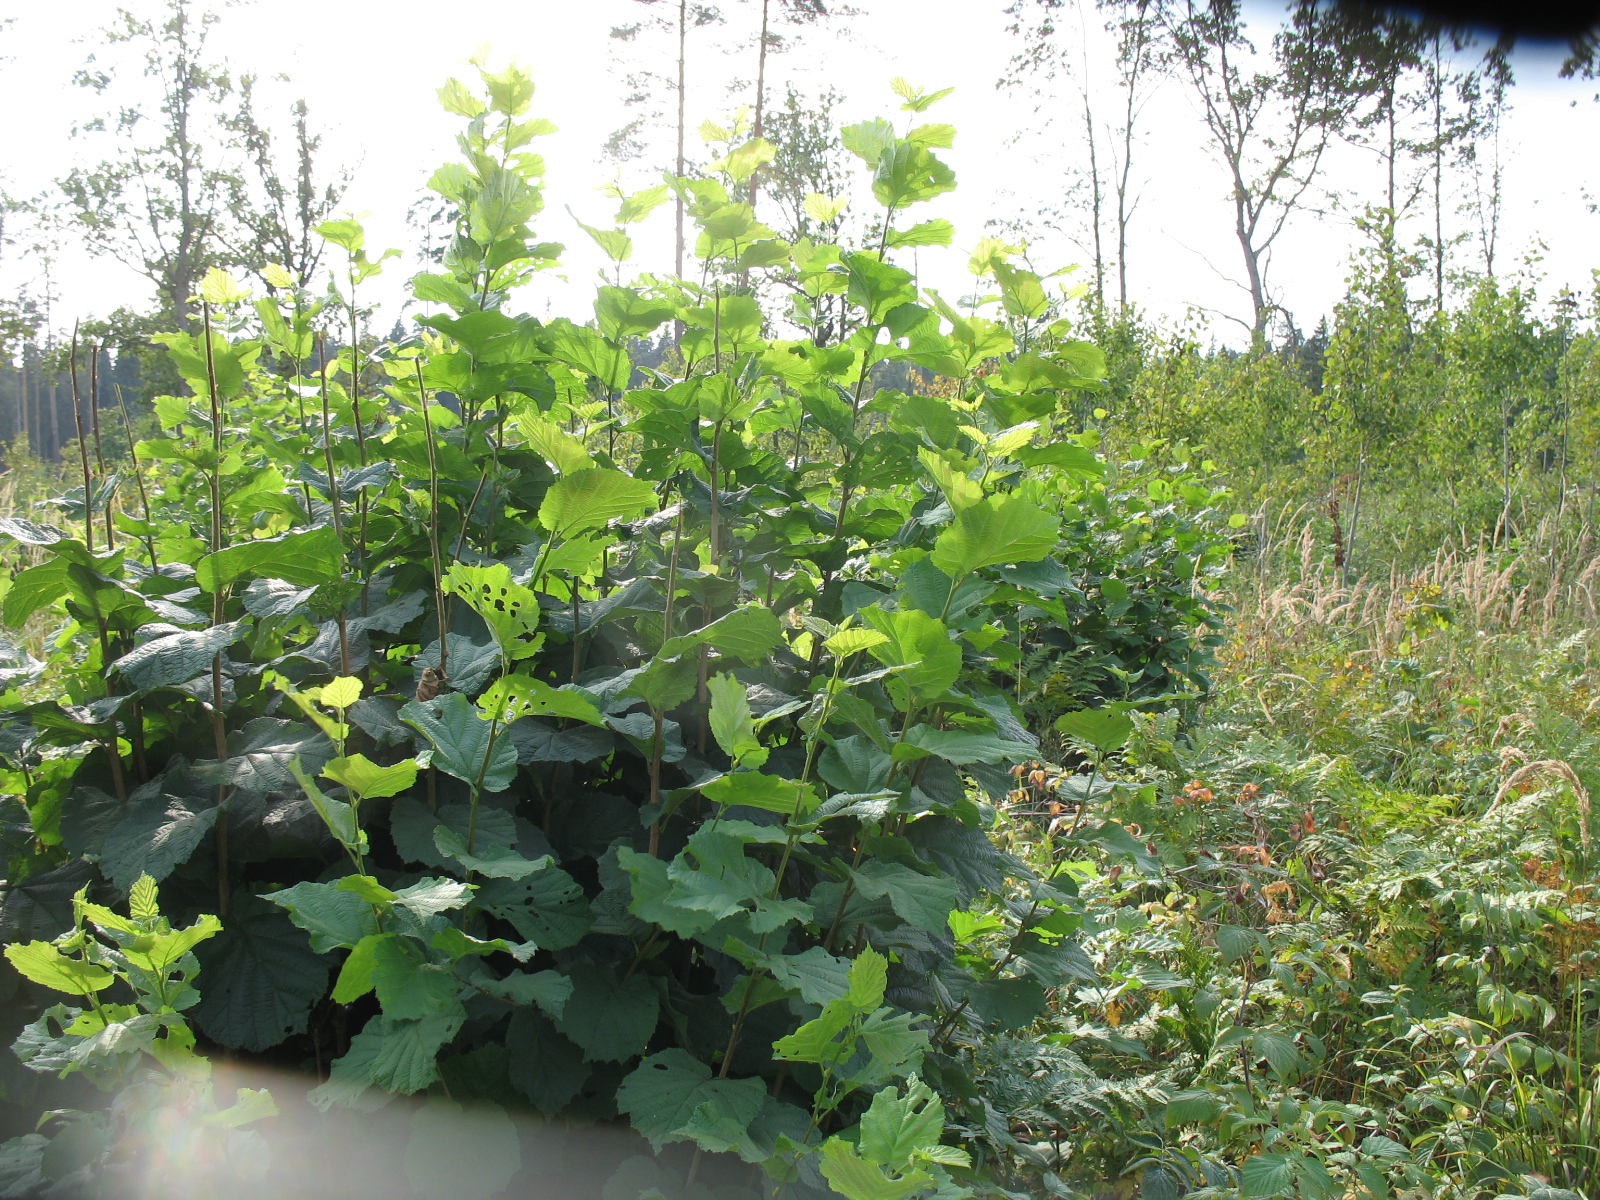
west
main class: Woodland
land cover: Broadleaved woodland
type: non-riverine alder, birch or aspen forest
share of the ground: 10 - 25 %
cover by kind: herbaceous plants 60 %, broadleaved forest trees 20 %, shrubs 20 %
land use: Forestry
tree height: < 5 m
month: August
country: LV
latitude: 56.3128
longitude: 25.5609
